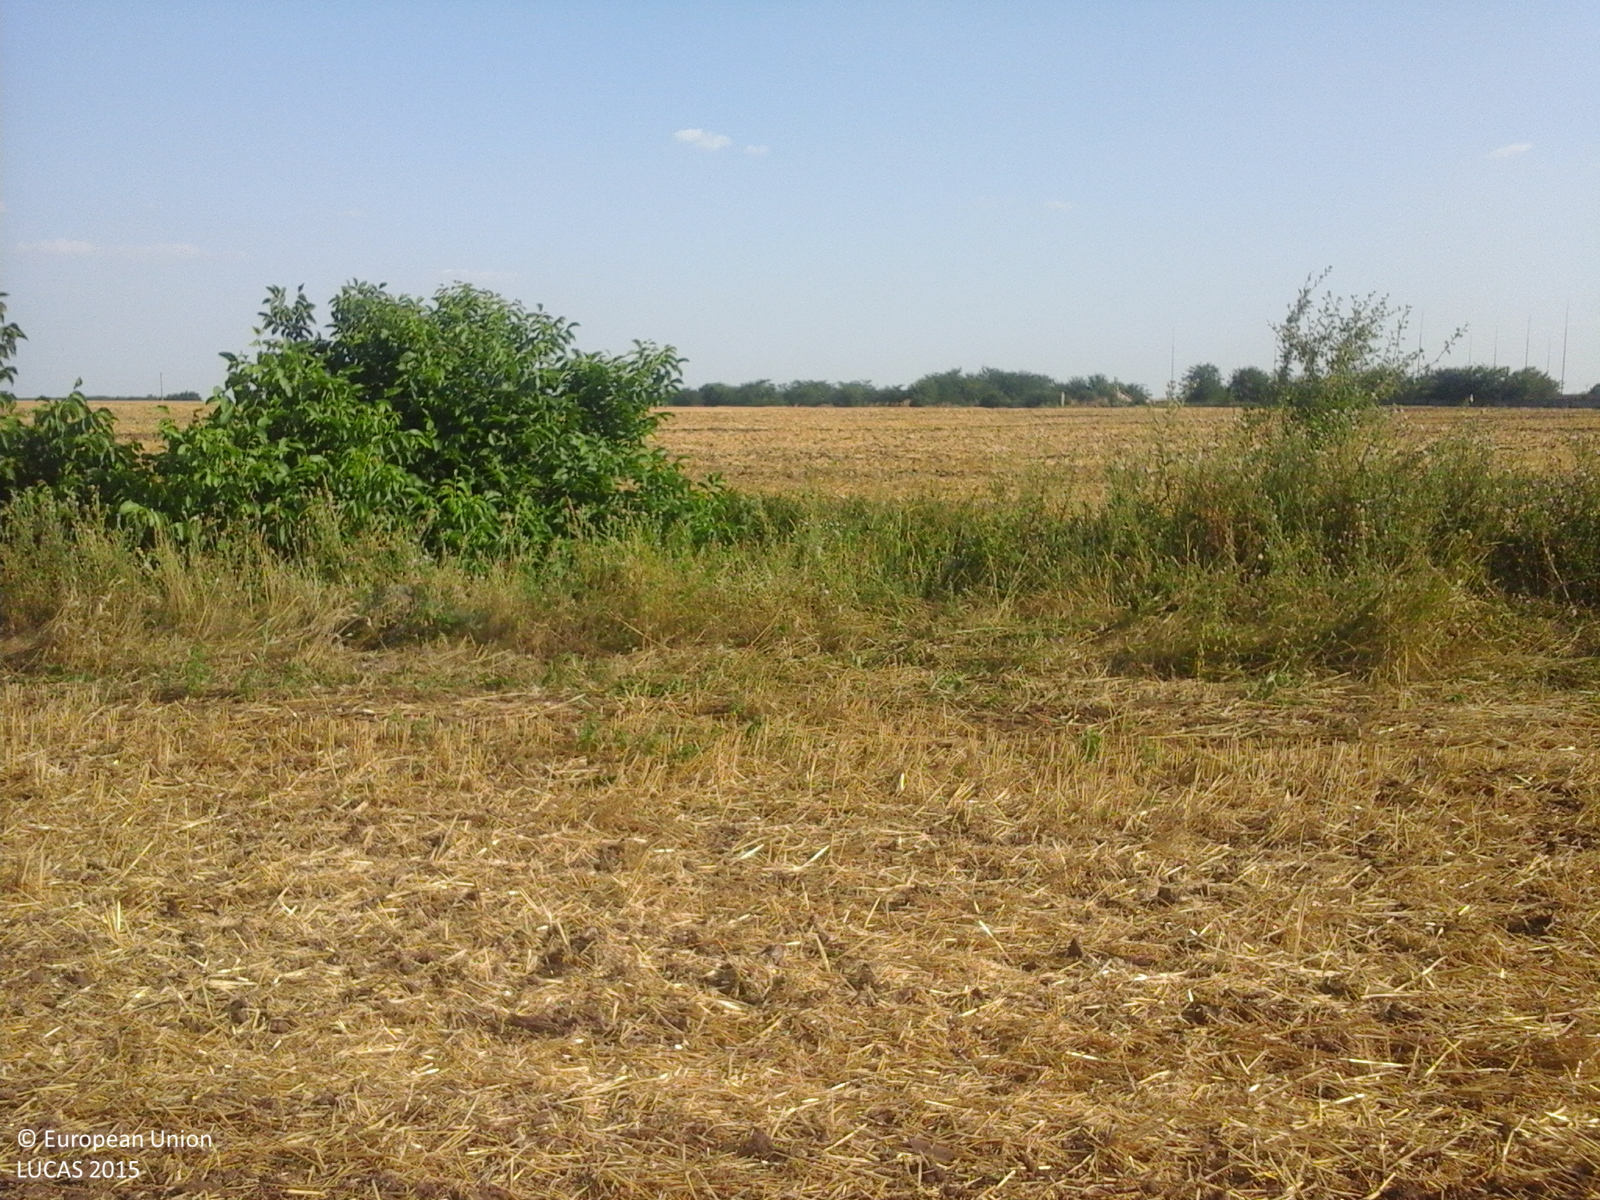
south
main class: Cropland
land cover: Common wheat
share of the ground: > 75 %
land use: Agriculture (excluding fallow land and kitchen gardens)
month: July
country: RO
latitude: 44.9135
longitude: 26.6021
